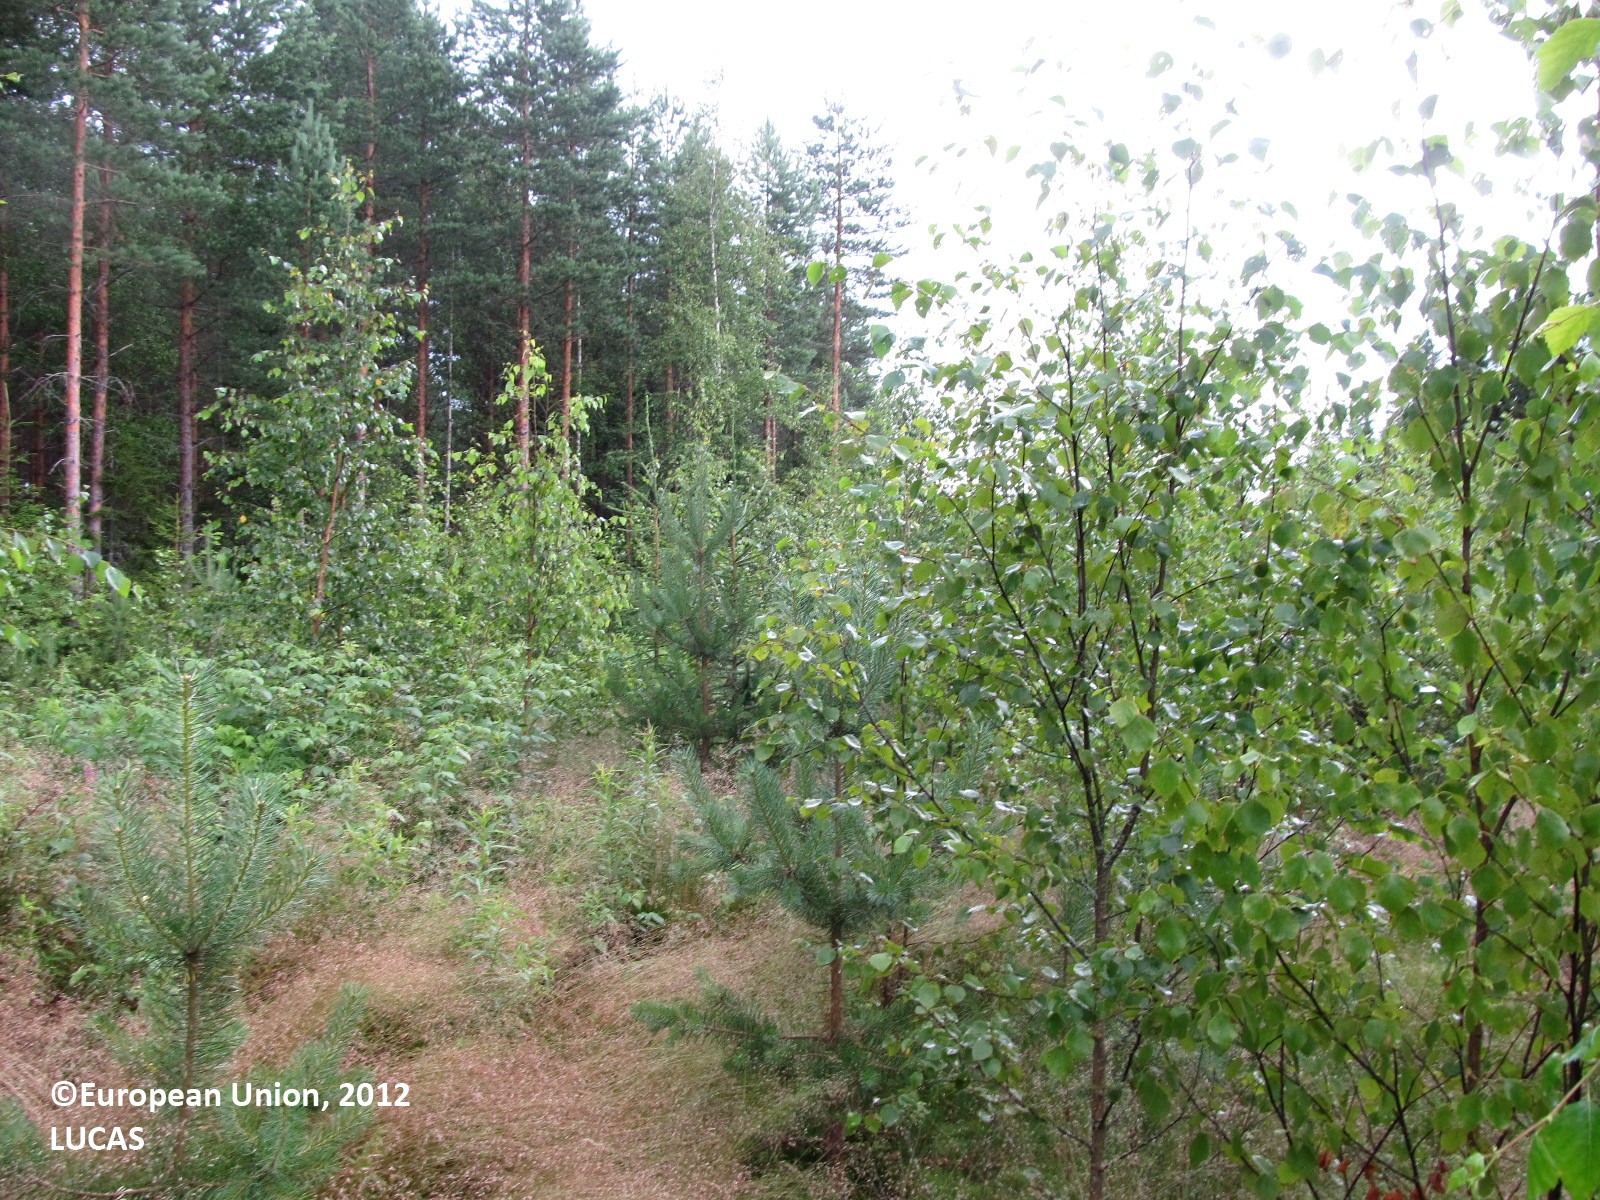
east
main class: Woodland
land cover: Broadleaved woodland
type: boreal forest
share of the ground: 25 - 50 %
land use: Forestry
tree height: < 5 m
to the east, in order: Broadleaved woodland; Spruce dominated mixed woodland; Pine dominated coniferous woodland; Paved roads, cycling and walking lanes; Pine dominated coniferous woodland; Spruce dominated coniferous woodland; Ditches and canals; Grassland with sparse tree/shrub cover
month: July
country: FI
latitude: 62.0234
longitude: 28.3741
